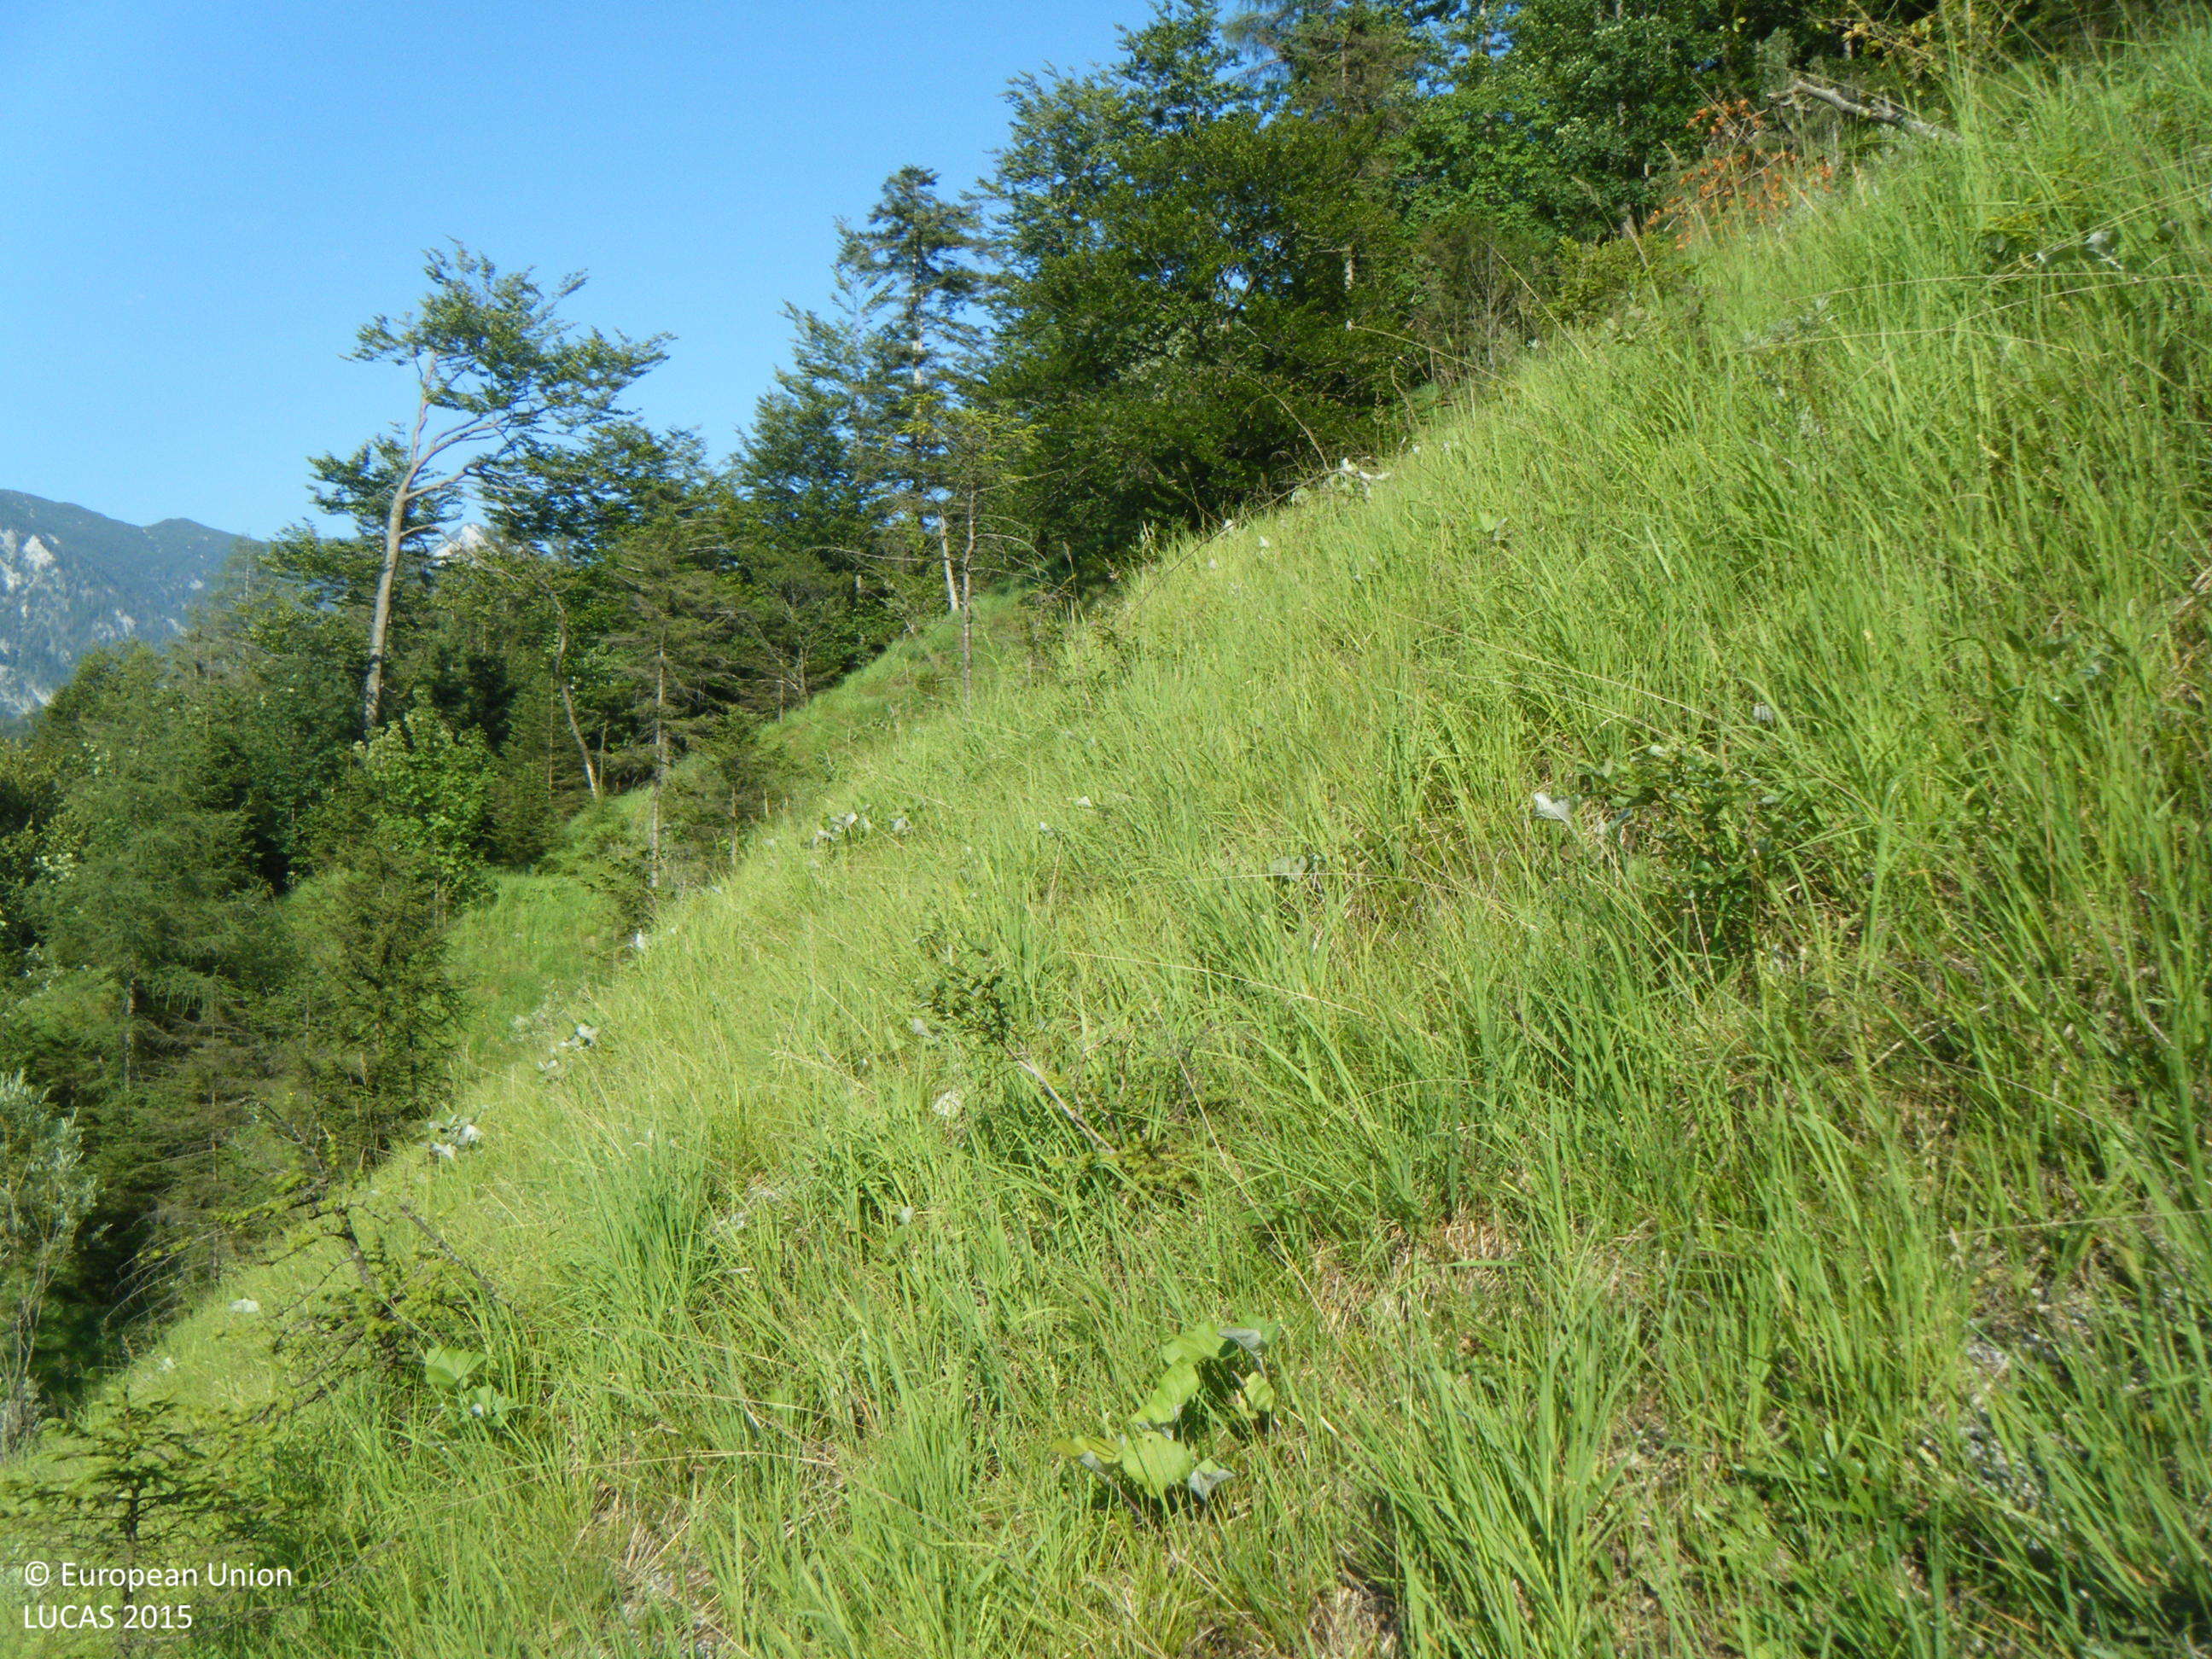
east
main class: Grassland
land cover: Grassland with sparse tree/shrub cover
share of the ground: > 75 %
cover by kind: herbaceous plants 75 %, shrubs 10 %, unconsolidated bare surface 10 %, coniferous forest trees 5 %
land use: Semi-natural and natural areas not in use
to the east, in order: Grassland with sparse tree/shrub cover; Shrubland with sparse tree cover; Sand; Ditches and canals; Sand; Spruce dominated coniferous woodland; Spruce dominated mixed woodland; Tracks; Spruce dominated mixed woodland; Ditches and canals; Spruce dominated mixed woodland
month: July
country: AT
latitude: 47.7877
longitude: 13.5627
